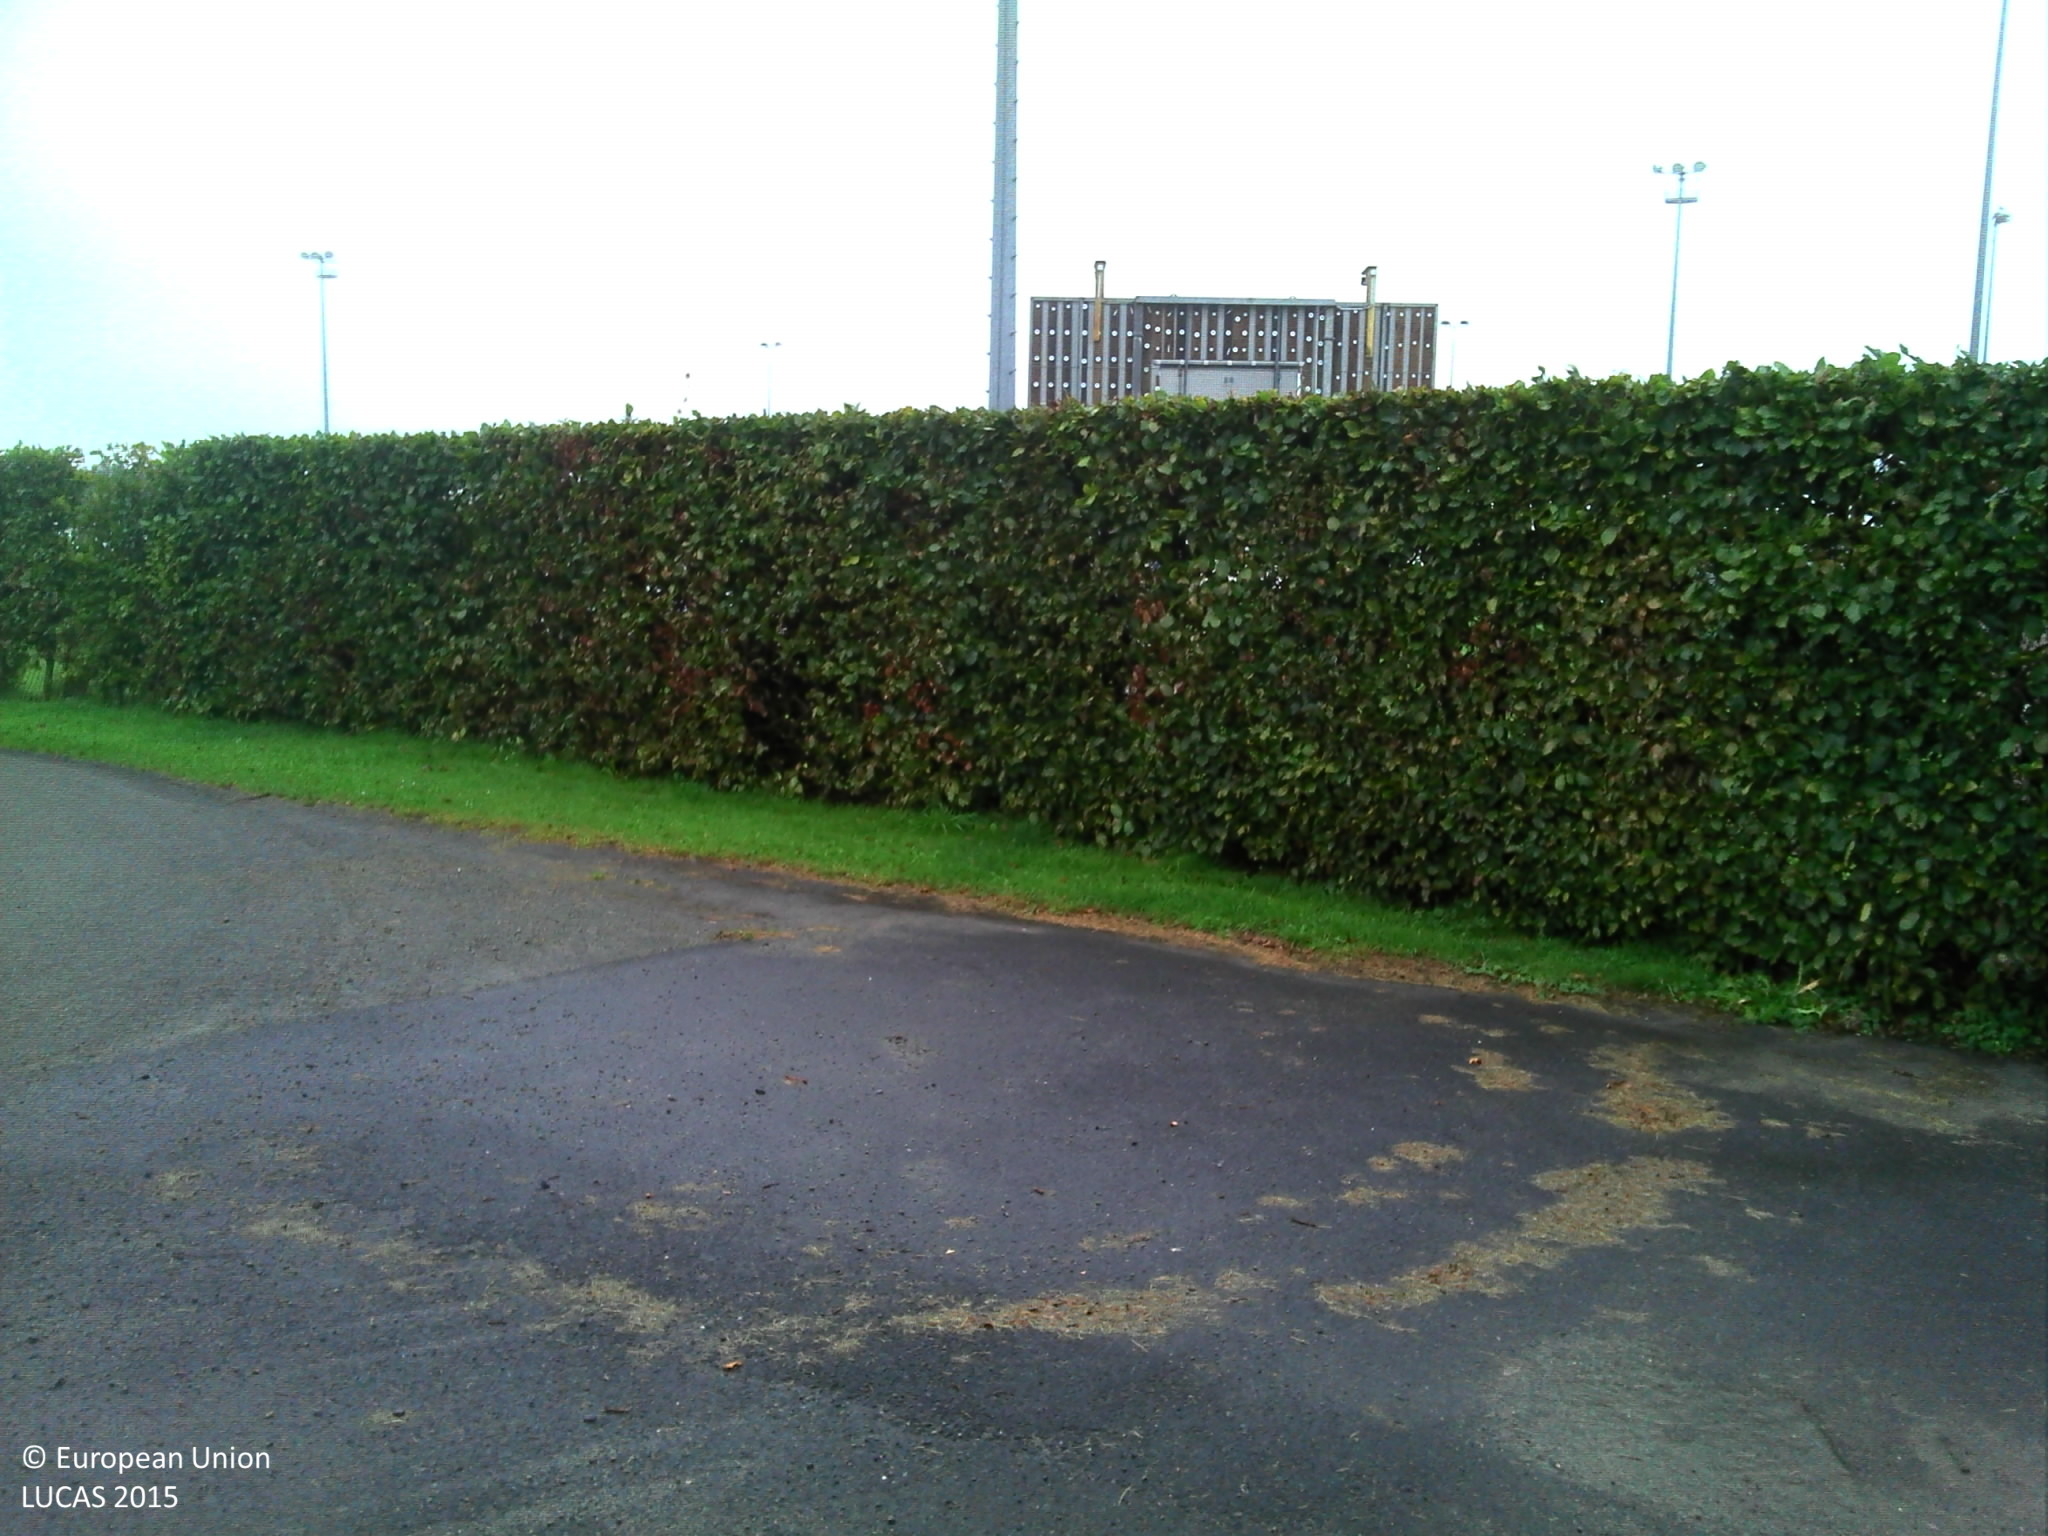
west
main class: Grassland
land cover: Grassland without tree/shrub cover
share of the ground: > 75 %
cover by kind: herbaceous plants 100 %
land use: Sport
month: October
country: BE
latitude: 51.0262
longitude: 2.8746
